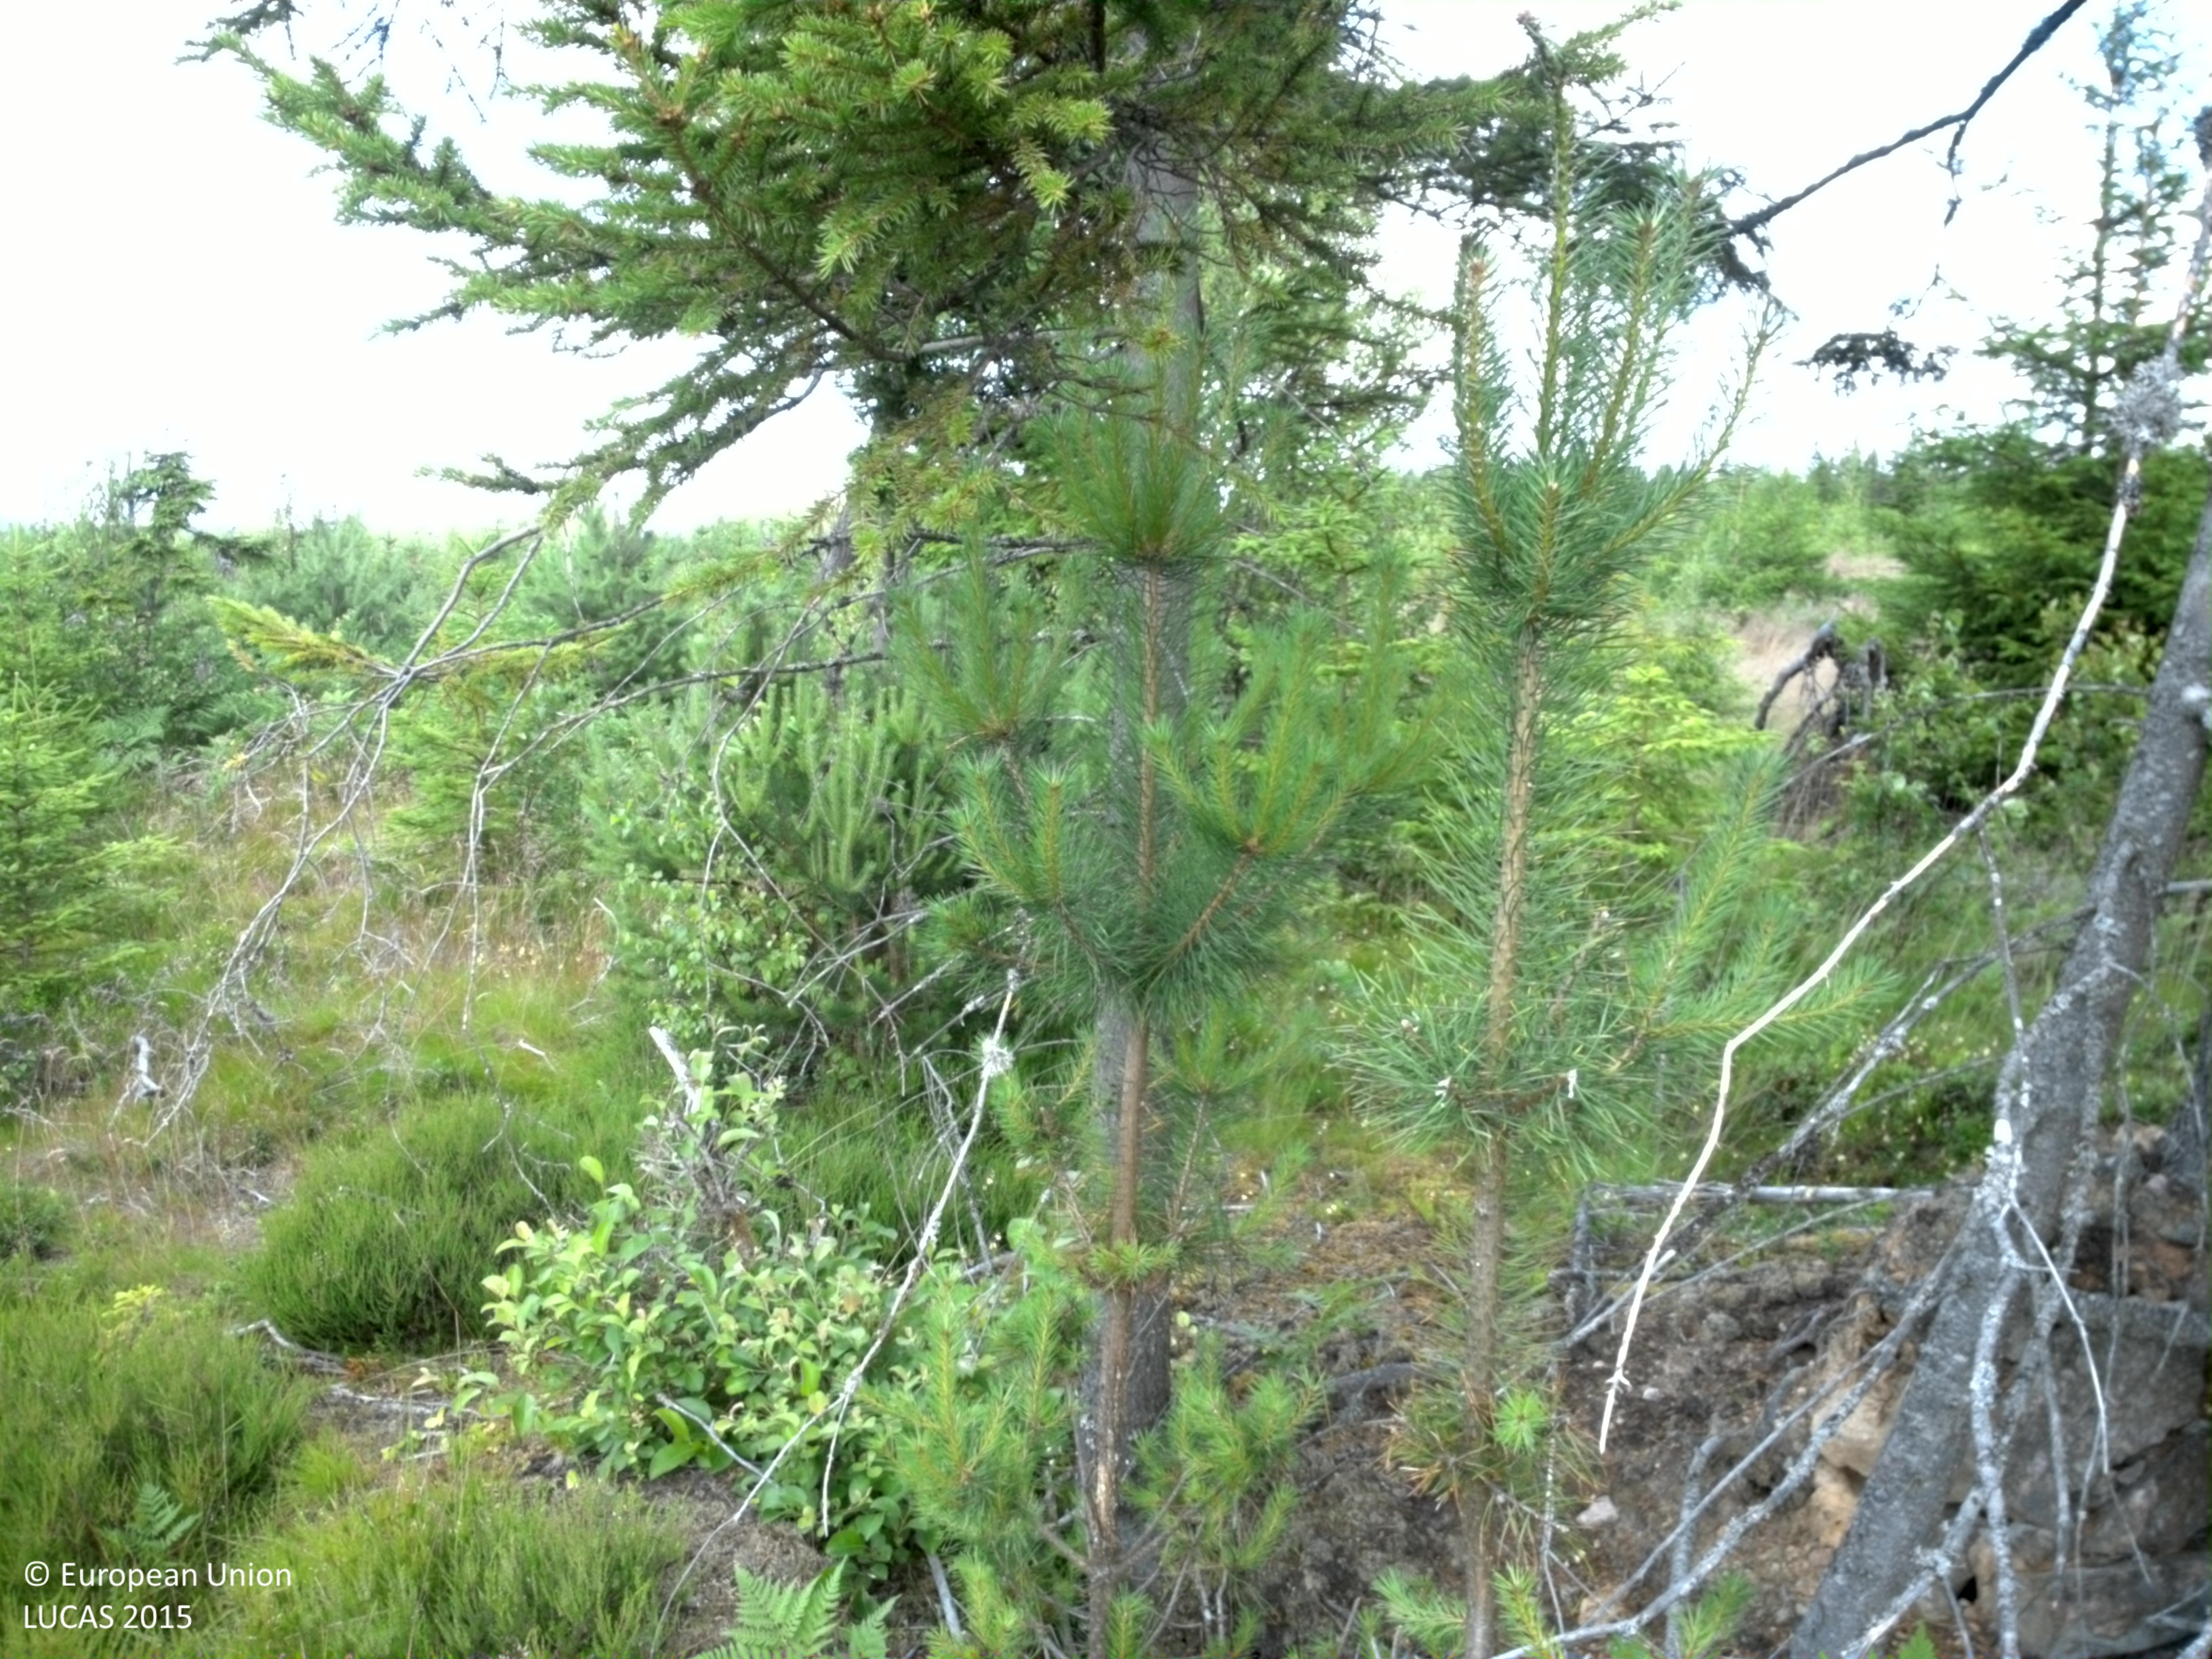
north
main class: Woodland
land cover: Other mixed woodland
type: boreal forest
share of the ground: 50 - 75 %
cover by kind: coniferous forest trees 40 %, broadleaved forest trees 20 %, herbaceous plants 20 %, shrubs 10 %, lichens and mosses 10 %
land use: Forestry
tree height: < 5 m
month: July
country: SE
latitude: 58.8633
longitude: 14.5527
